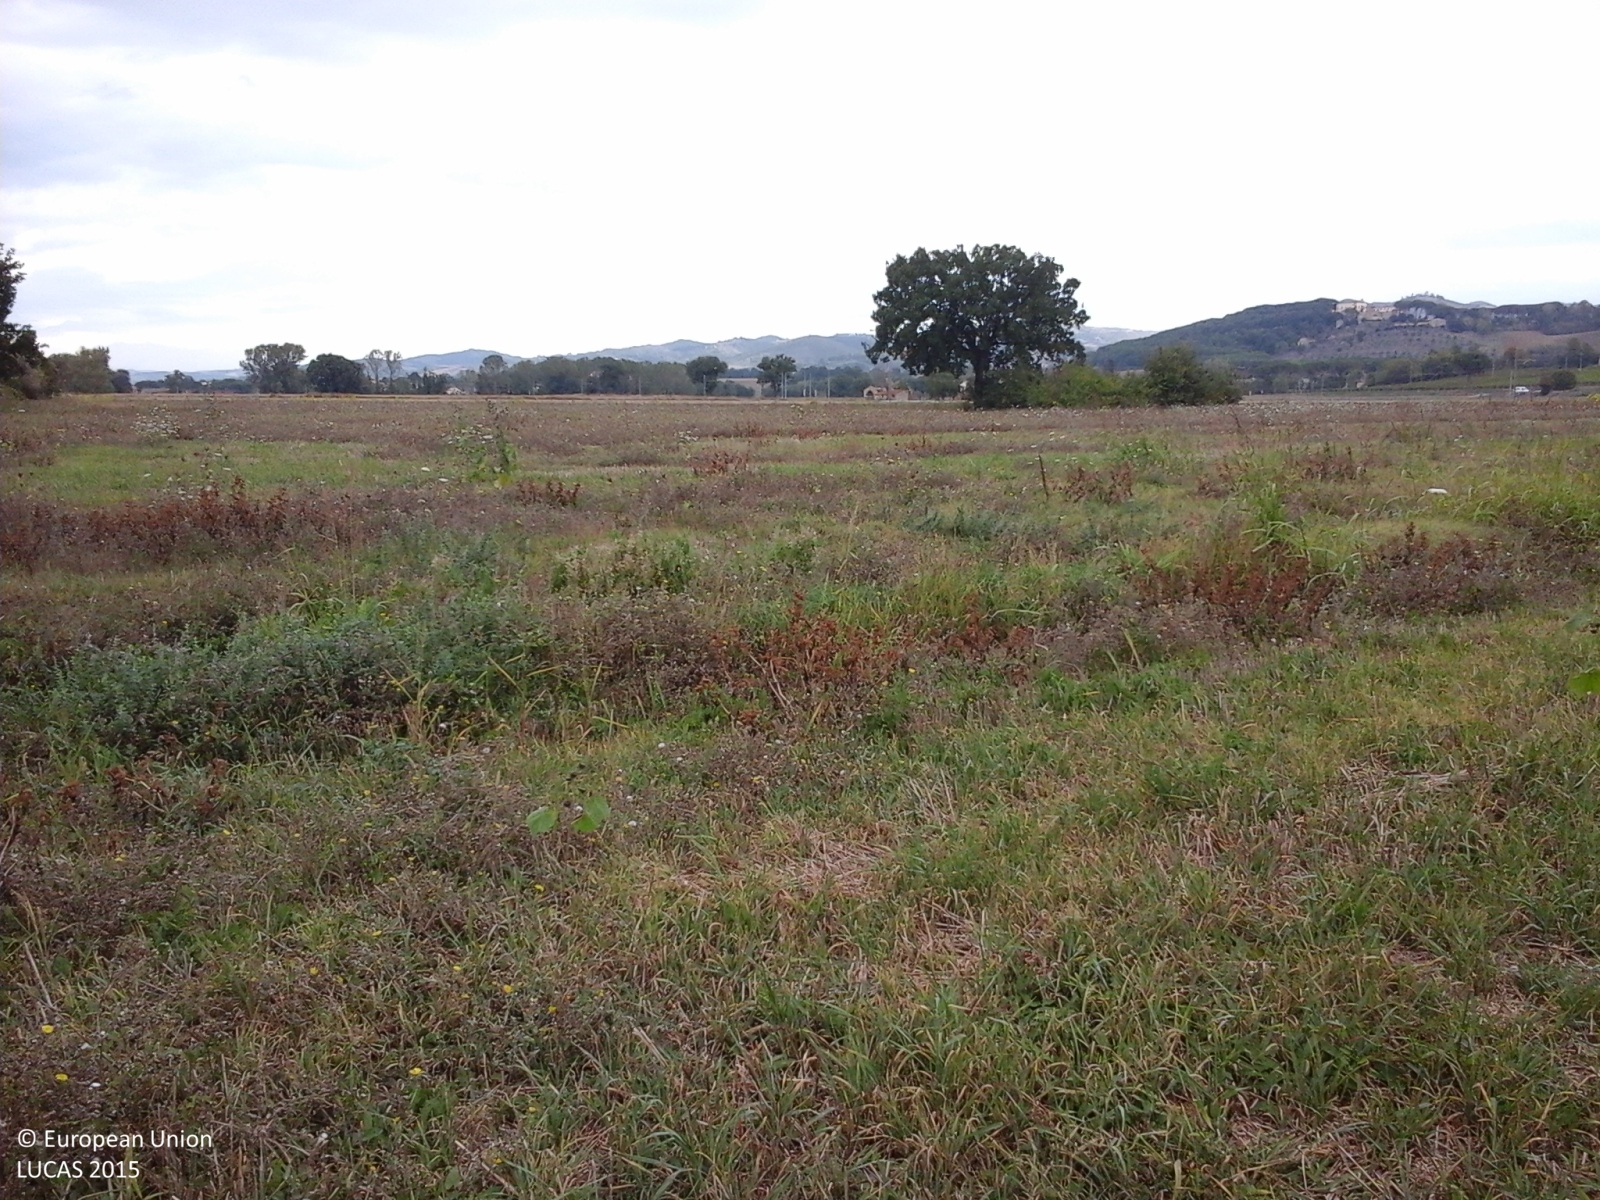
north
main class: Grassland
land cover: Spontaneously vegetated surfaces
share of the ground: 50 - 75 %
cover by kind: herbaceous plants 100 %
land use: Fallow land
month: October
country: IT
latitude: 43.2032
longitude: 12.4177
